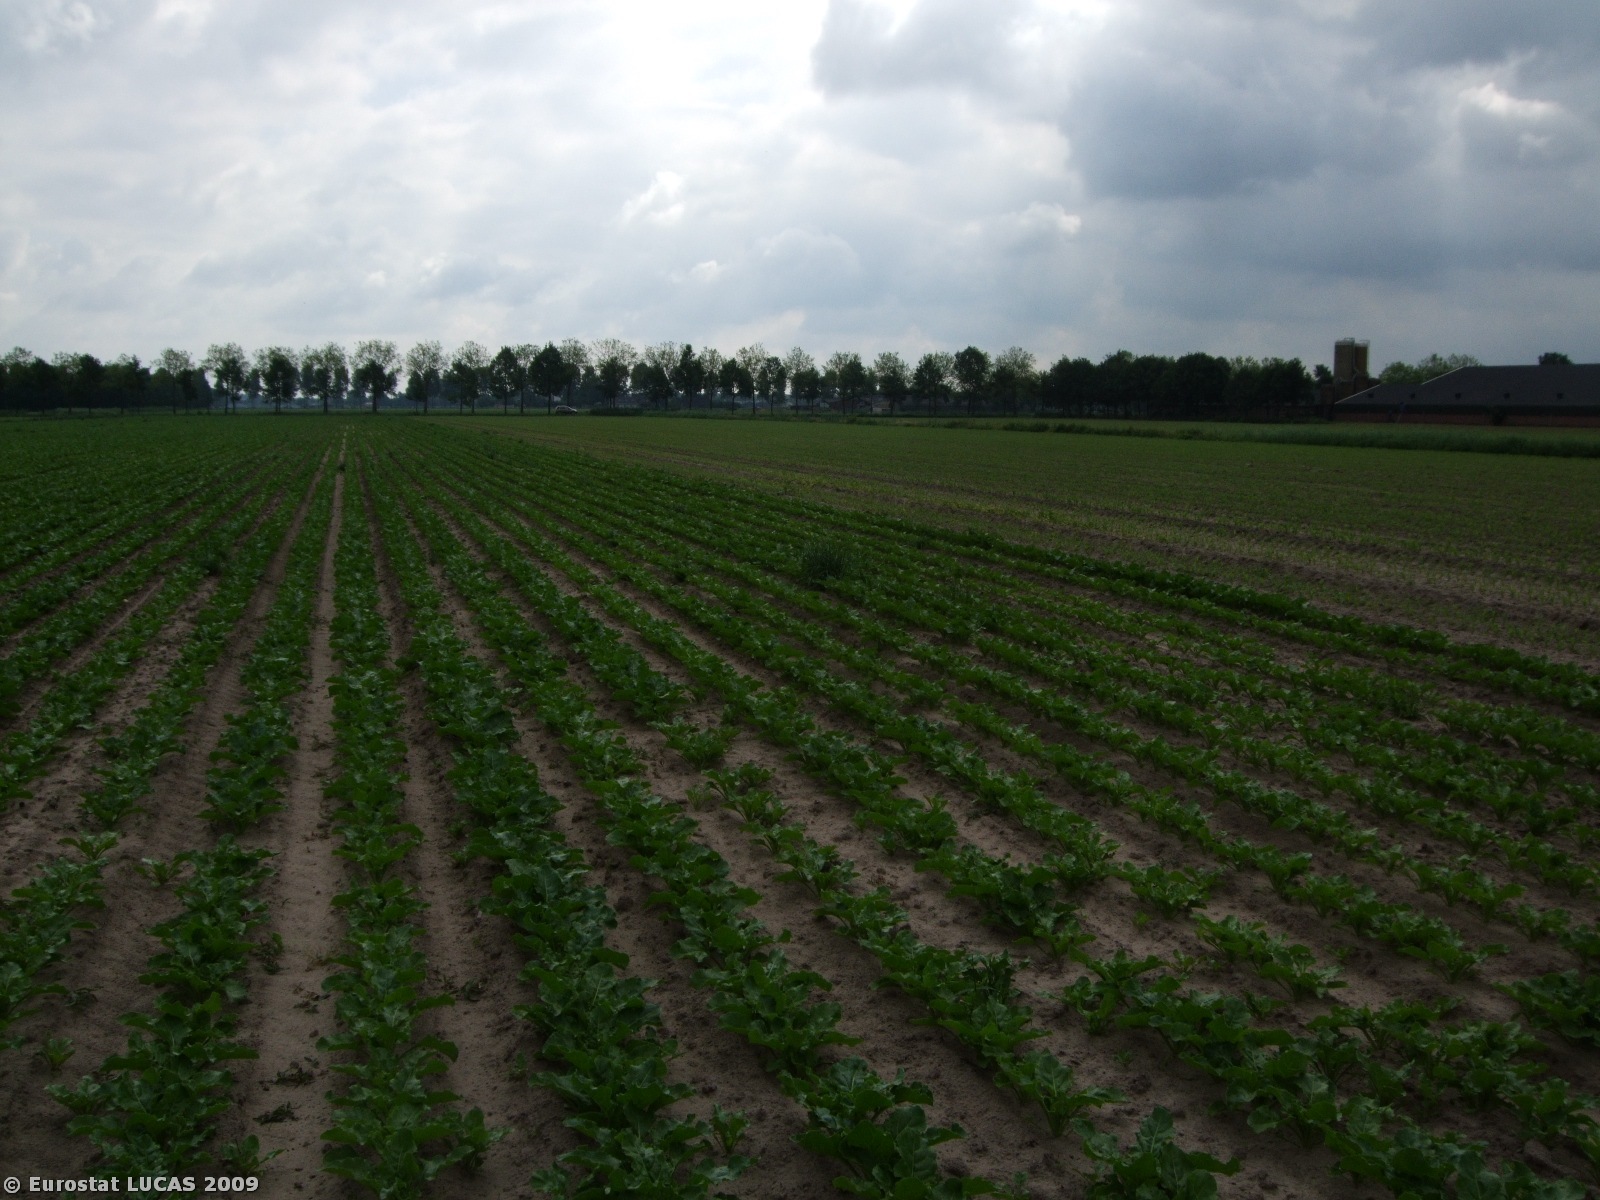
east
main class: Cropland
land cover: Sugar beet
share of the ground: 50 - 75 %
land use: Agriculture (excluding fallow land and kitchen gardens)
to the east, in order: Sugar beet; Maize; Ditches and canals; Maize
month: May
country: NL
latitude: 51.7137
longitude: 5.4390
